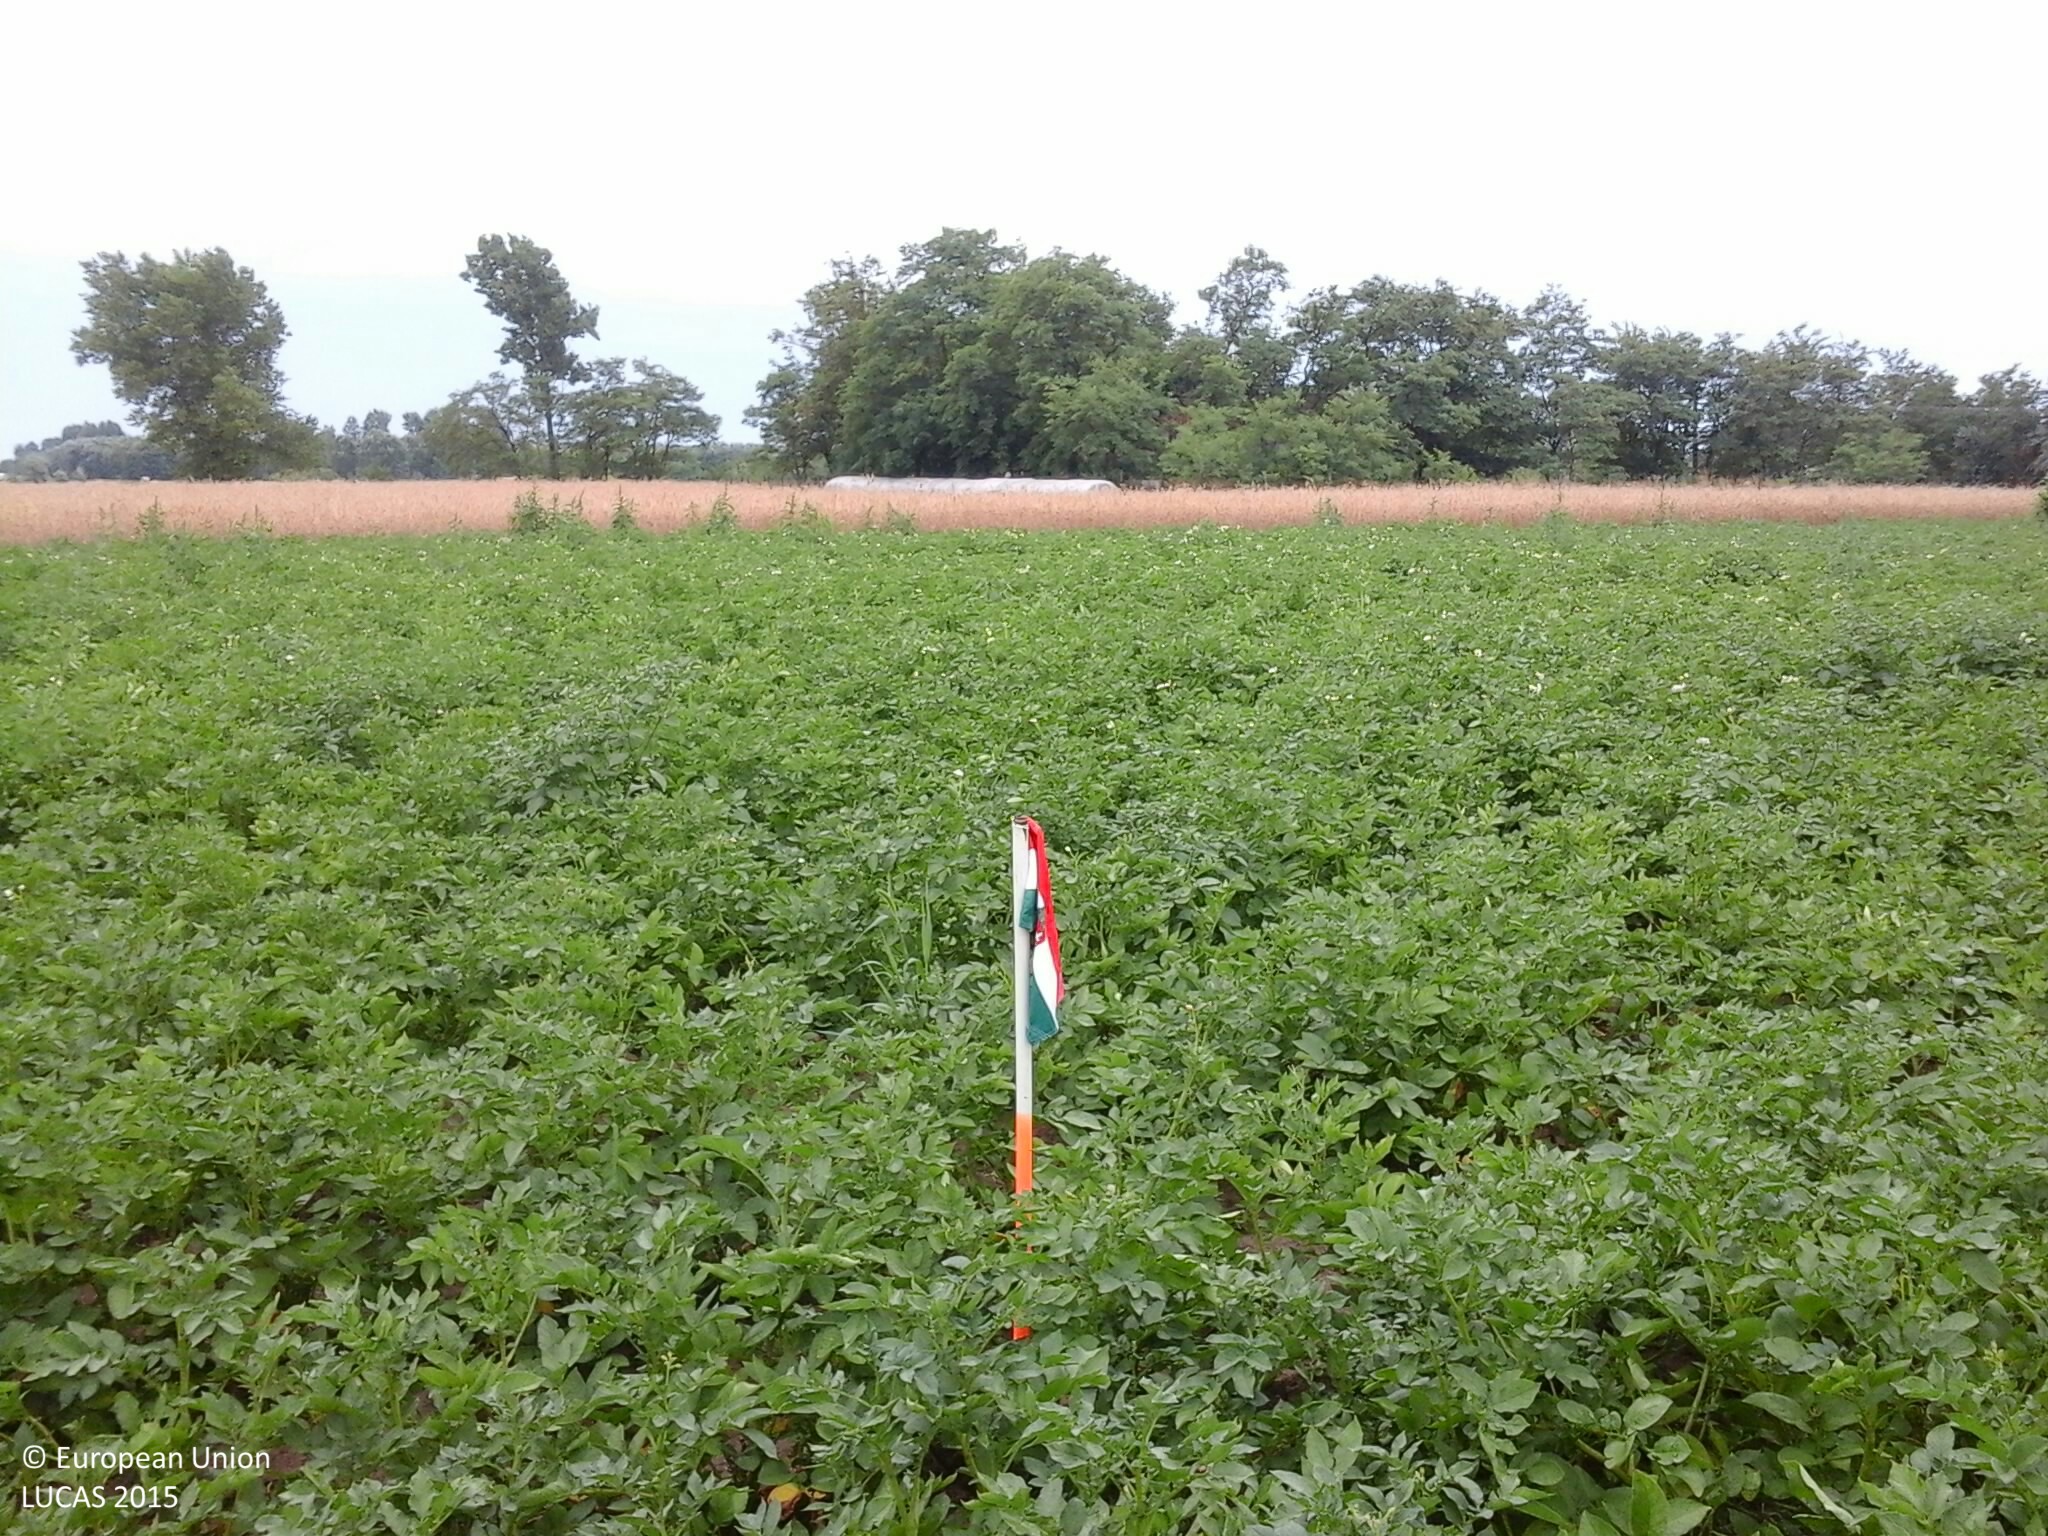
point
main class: Cropland
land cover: Potatoes
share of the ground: > 75 %
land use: Agriculture (excluding fallow land and kitchen gardens)
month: July
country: HU
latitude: 46.4766
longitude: 20.0379
